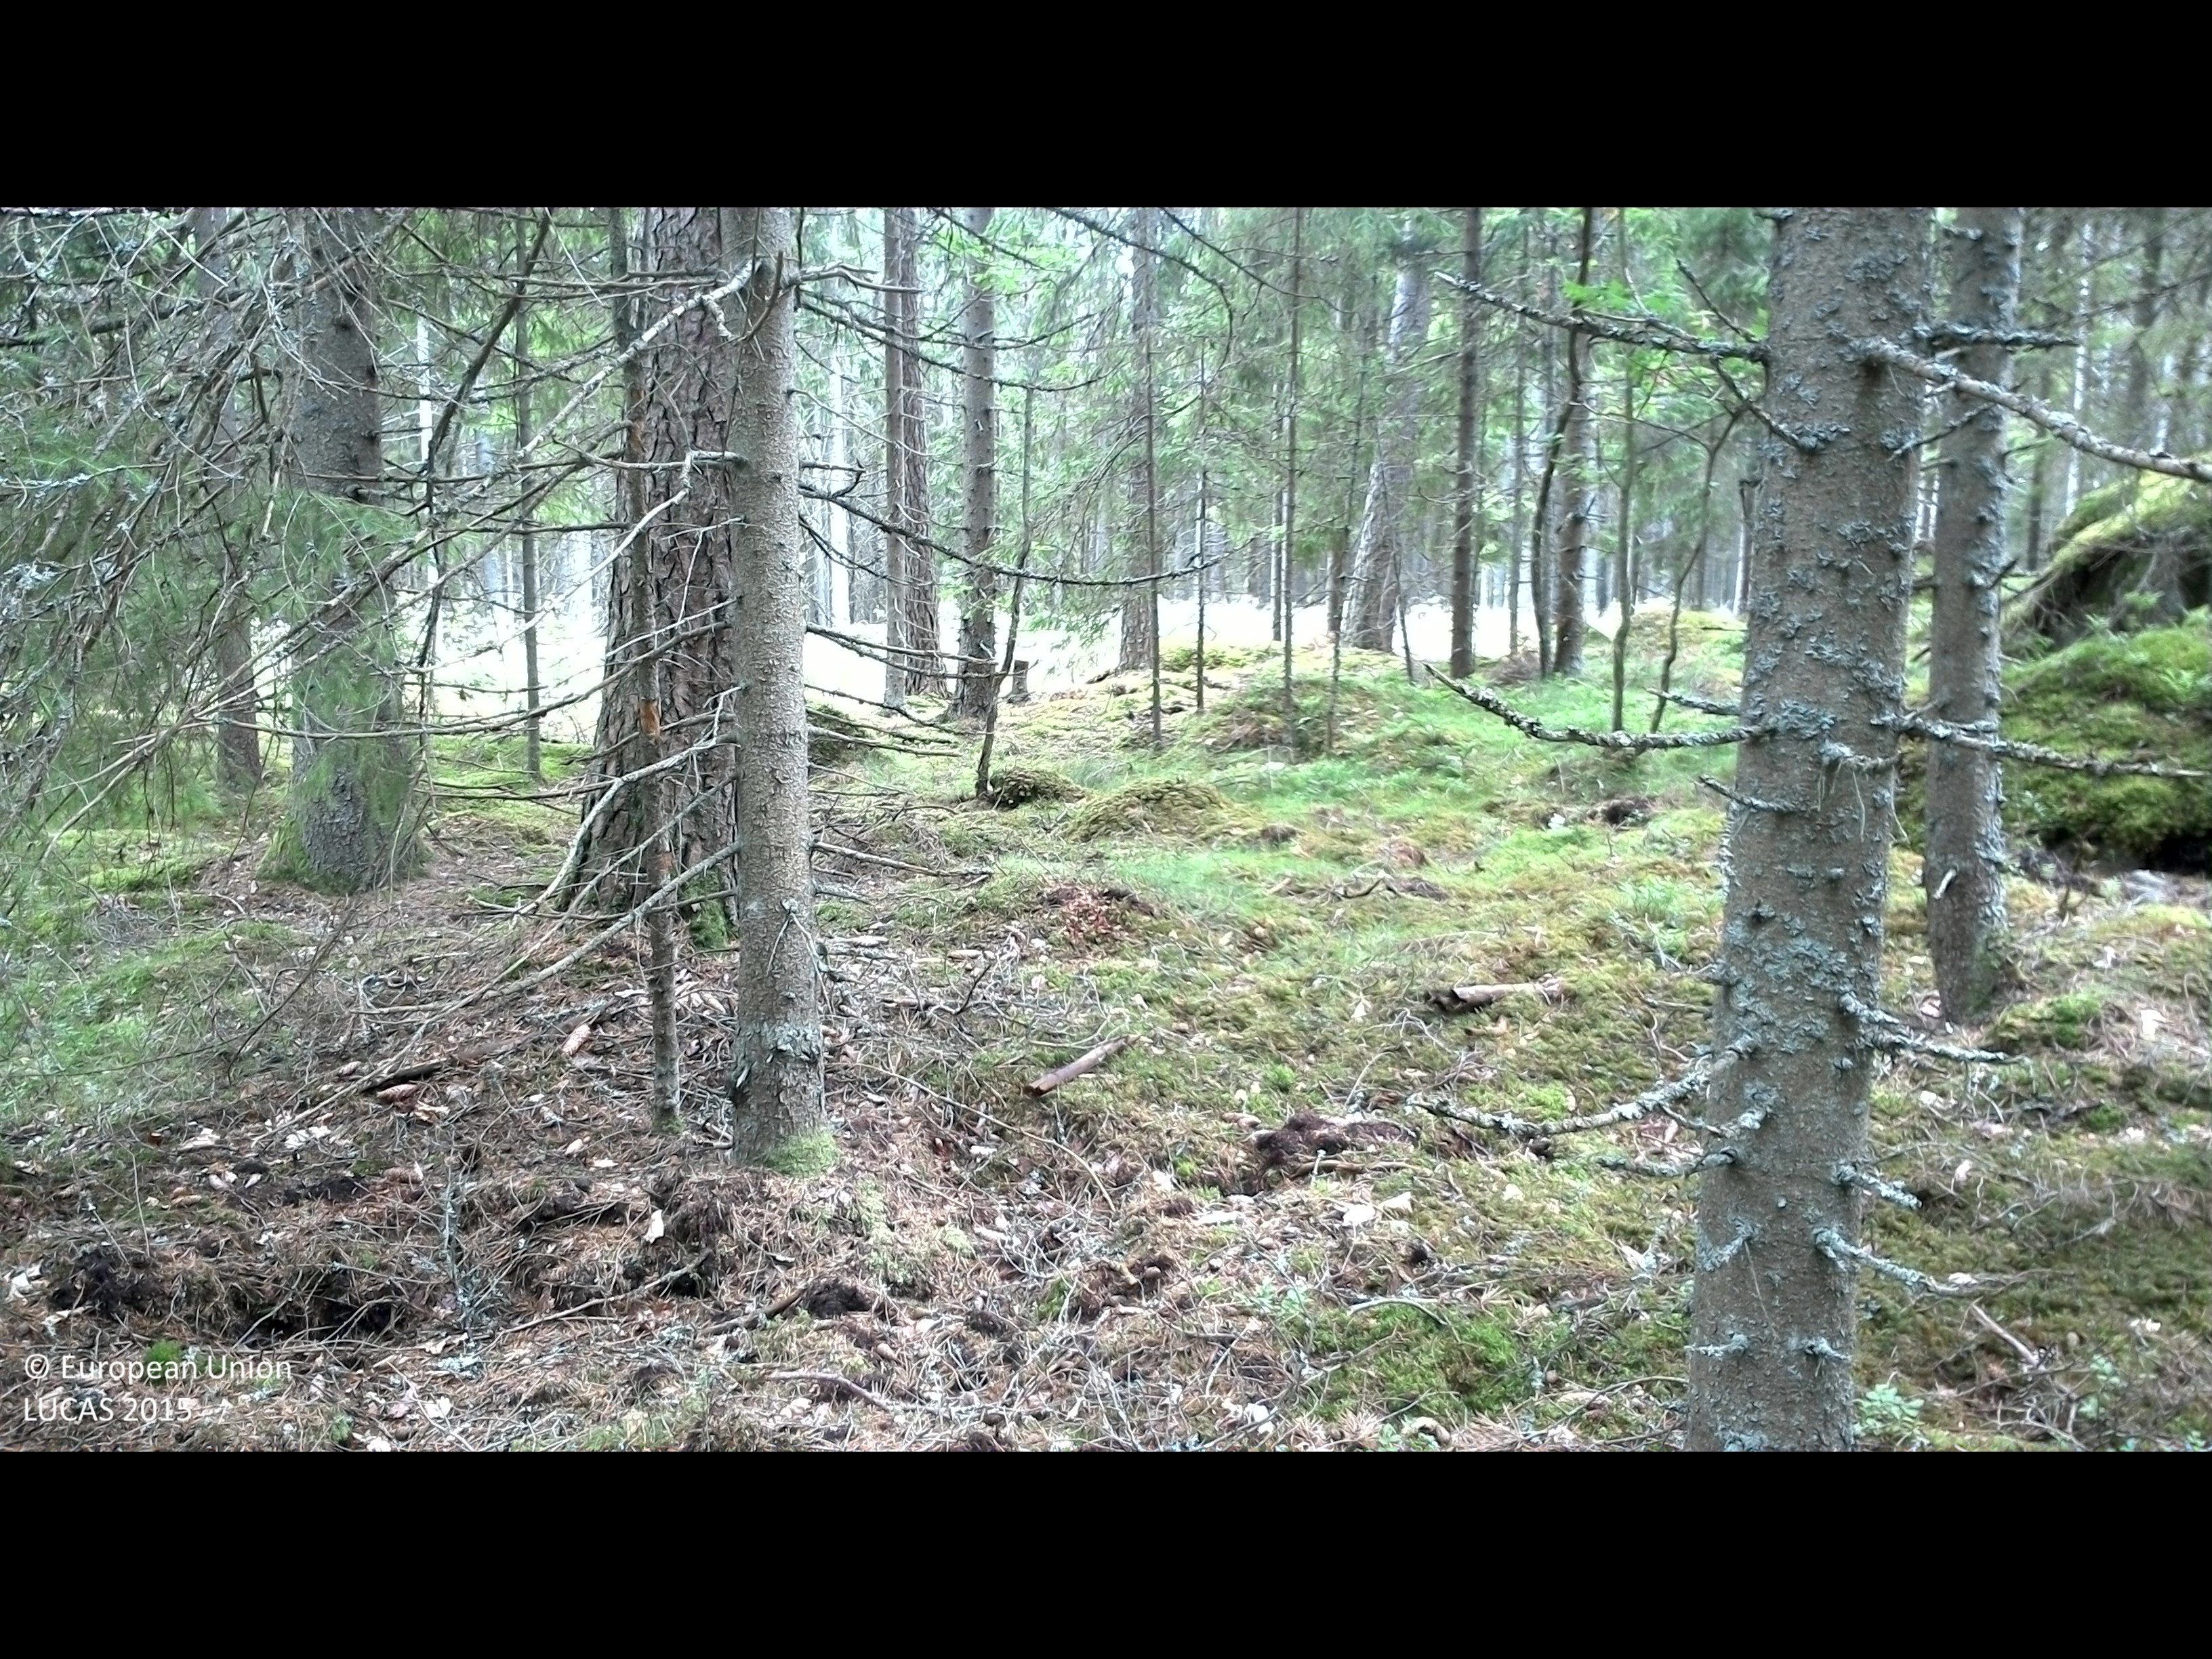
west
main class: Woodland
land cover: Spruce dominated coniferous woodland
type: boreal forest
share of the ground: > 75 %
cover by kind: coniferous forest trees 75 %, lichens and mosses 15 %, shrubs 10 %
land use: Forestry
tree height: > 5 m
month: July
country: SE
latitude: 56.4792
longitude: 14.7226
